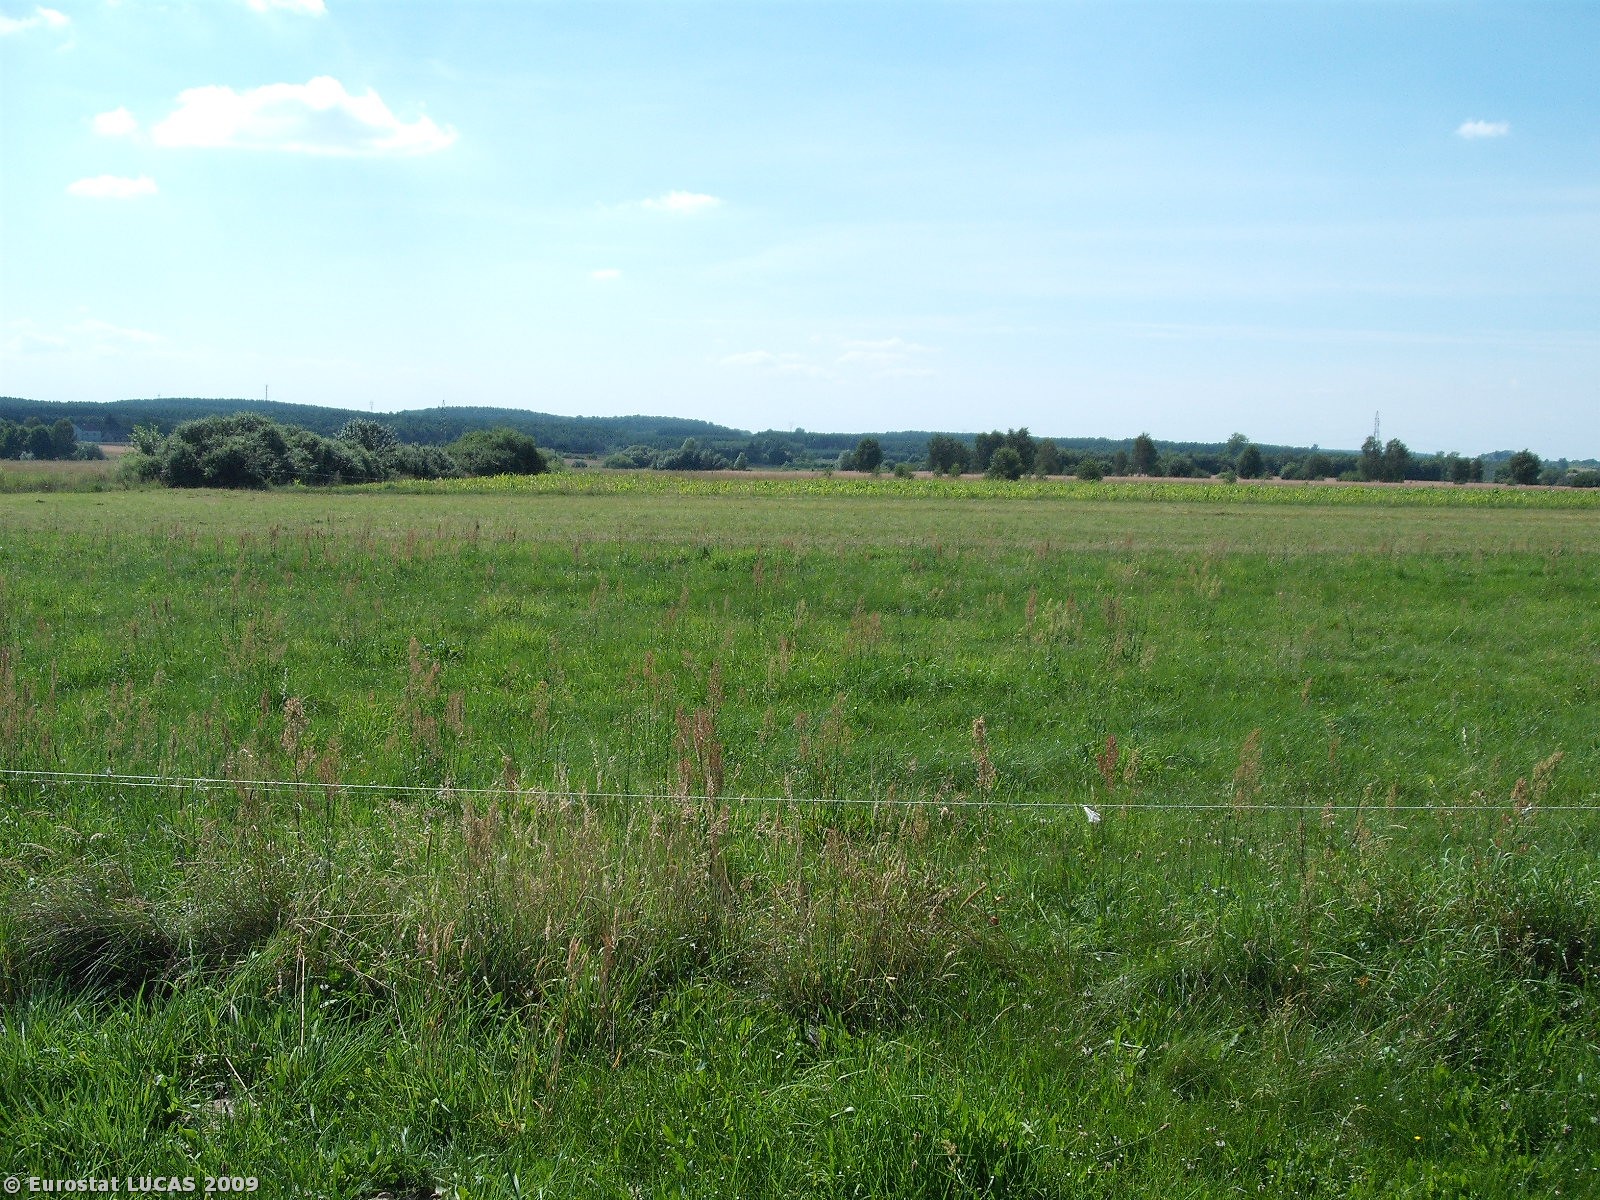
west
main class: Grassland
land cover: Grassland without tree/shrub cover
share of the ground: > 75 %
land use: Agriculture (excluding fallow land and kitchen gardens)
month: July
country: PL
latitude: 50.6747
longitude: 20.7246
